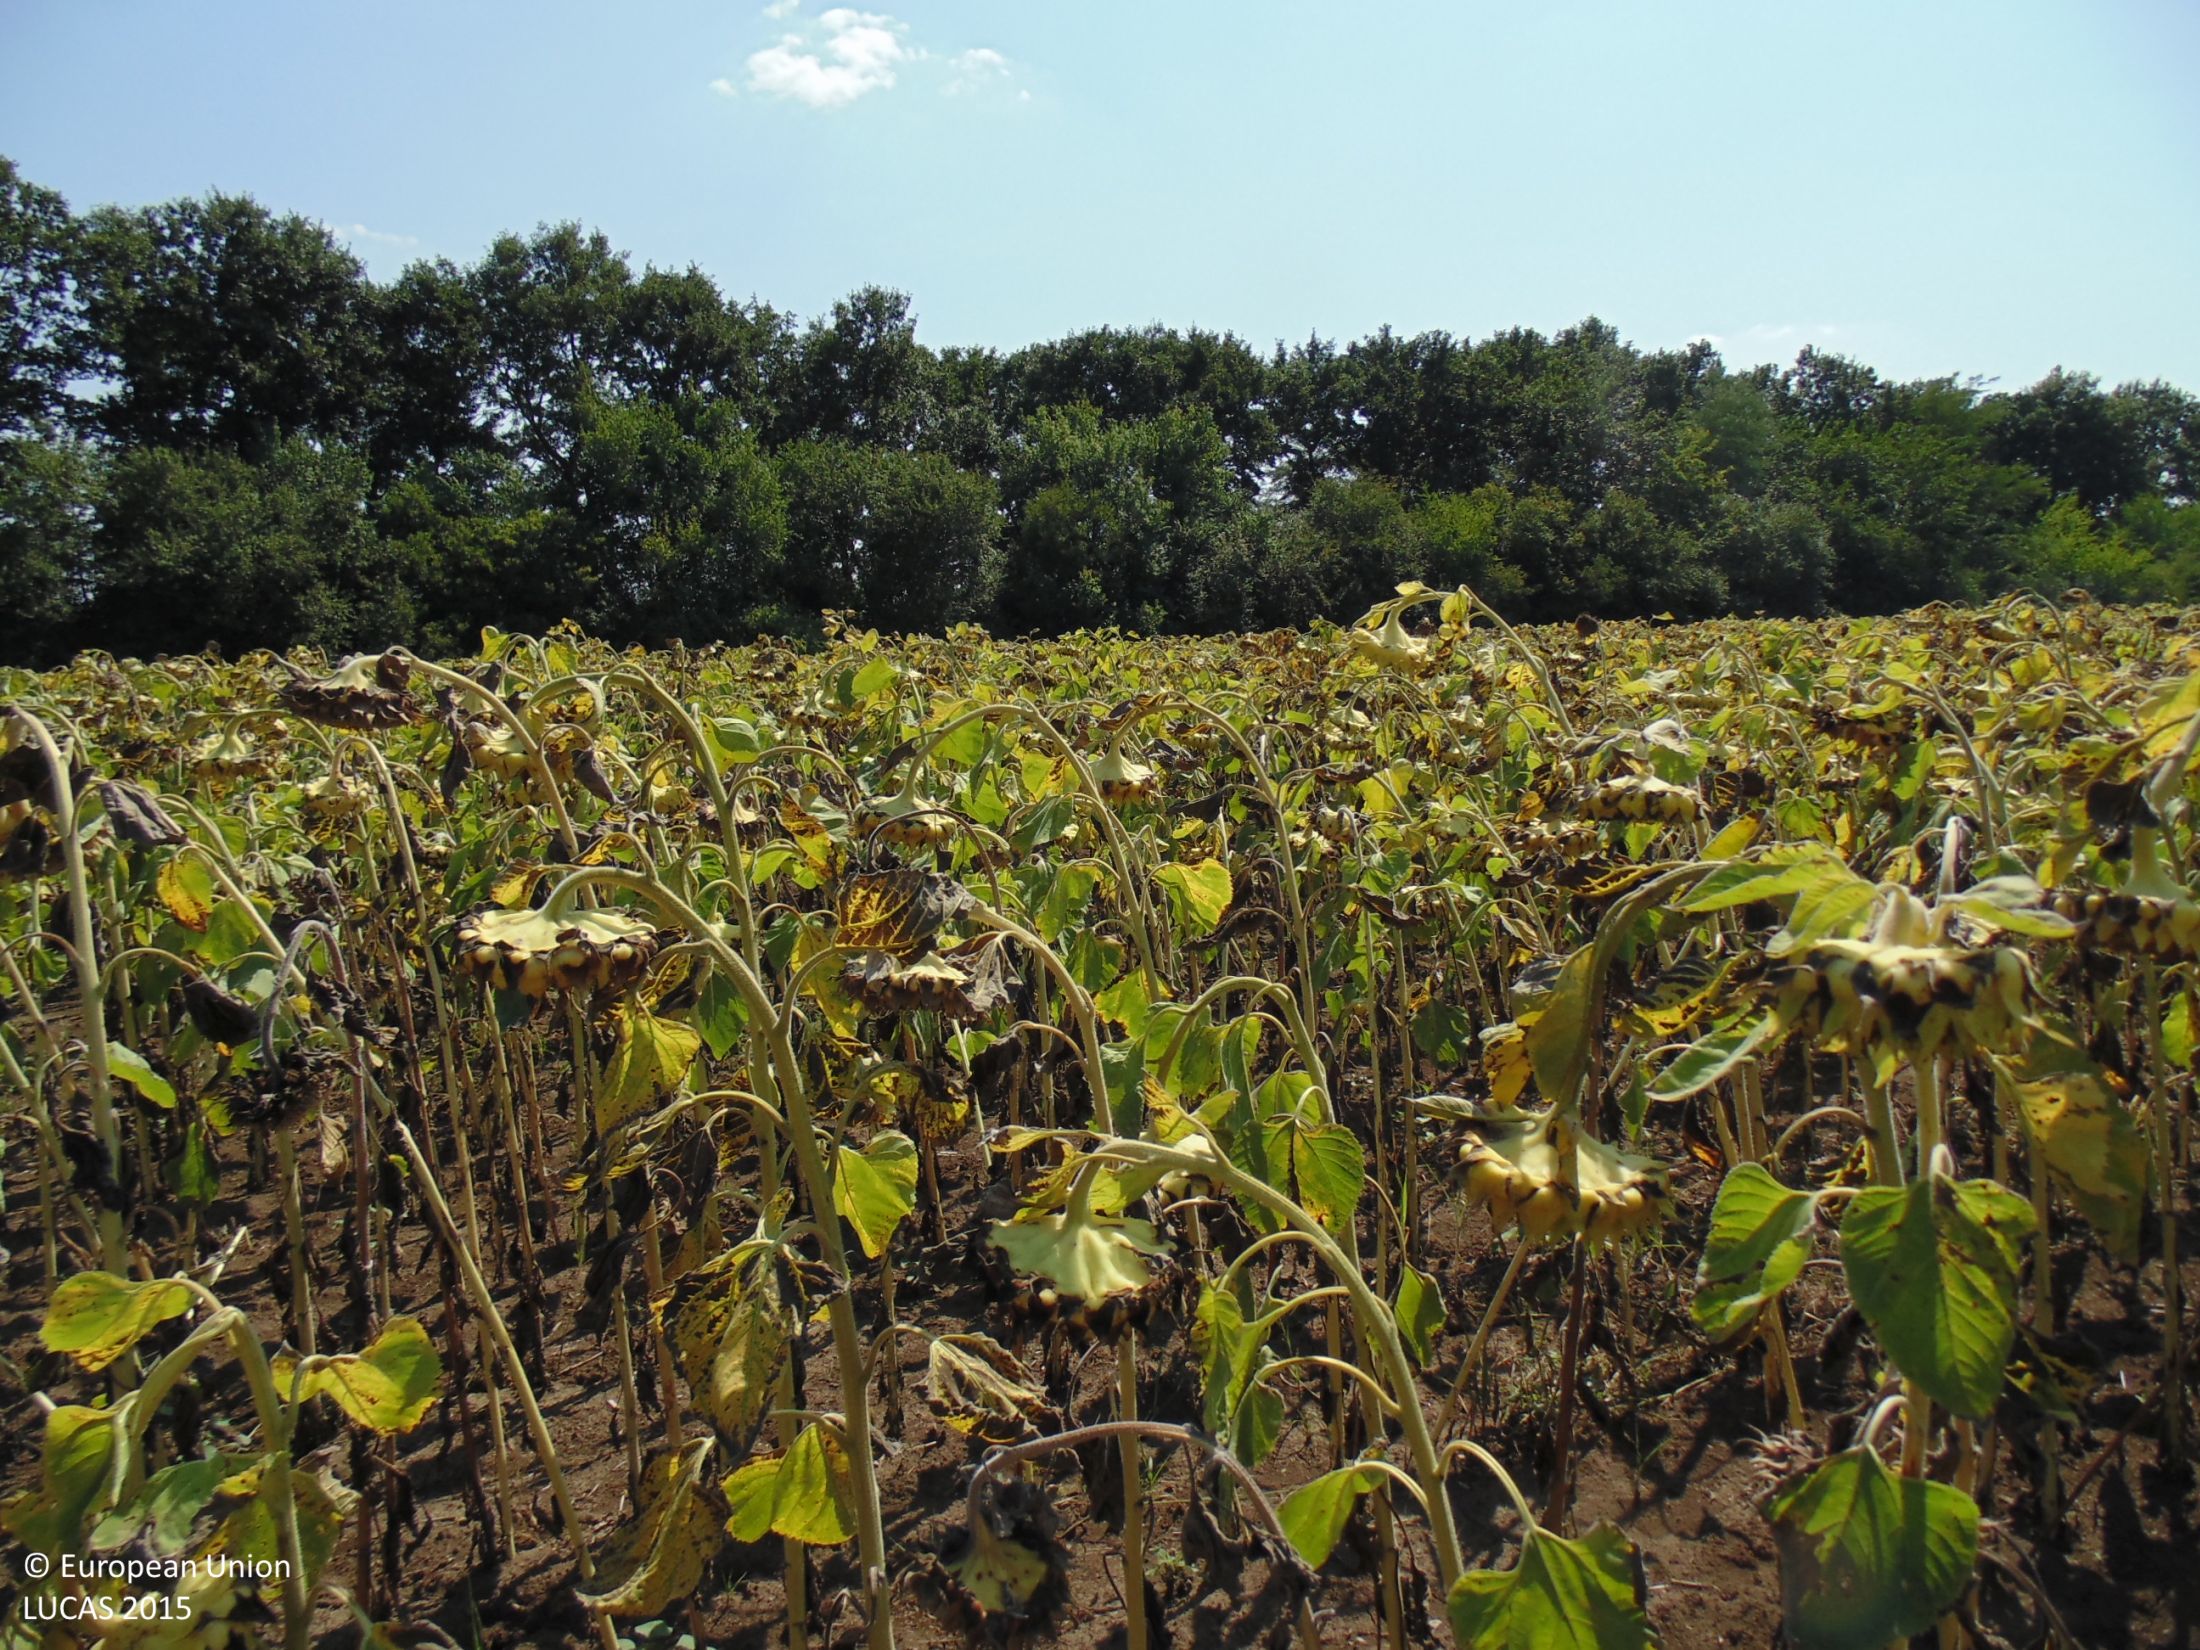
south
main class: Cropland
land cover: Sunflower
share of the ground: > 75 %
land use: Agriculture (excluding fallow land and kitchen gardens)
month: August
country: BG
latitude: 43.7547
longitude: 27.4842
